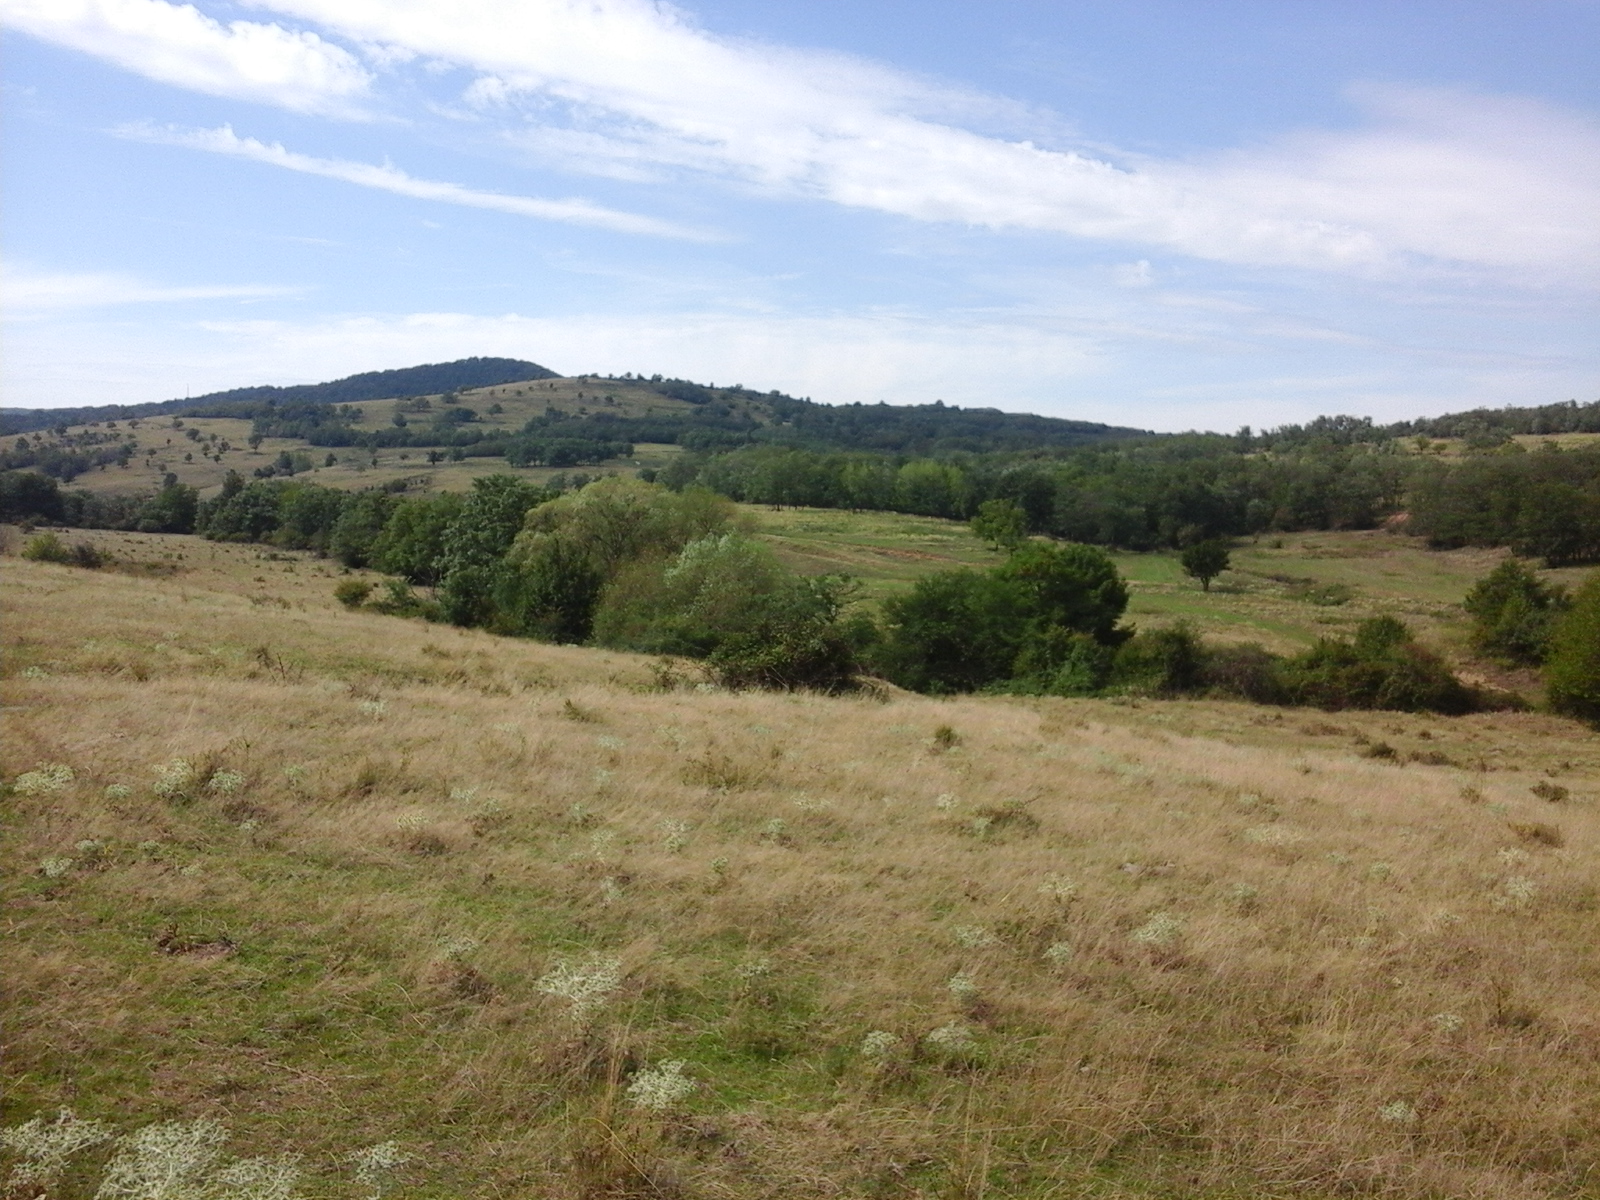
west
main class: Grassland
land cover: Grassland without tree/shrub cover
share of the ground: > 75 %
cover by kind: herbaceous plants 100 %
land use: Agriculture (excluding fallow land and kitchen gardens)
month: August
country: RO
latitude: 46.2673
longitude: 21.7300
